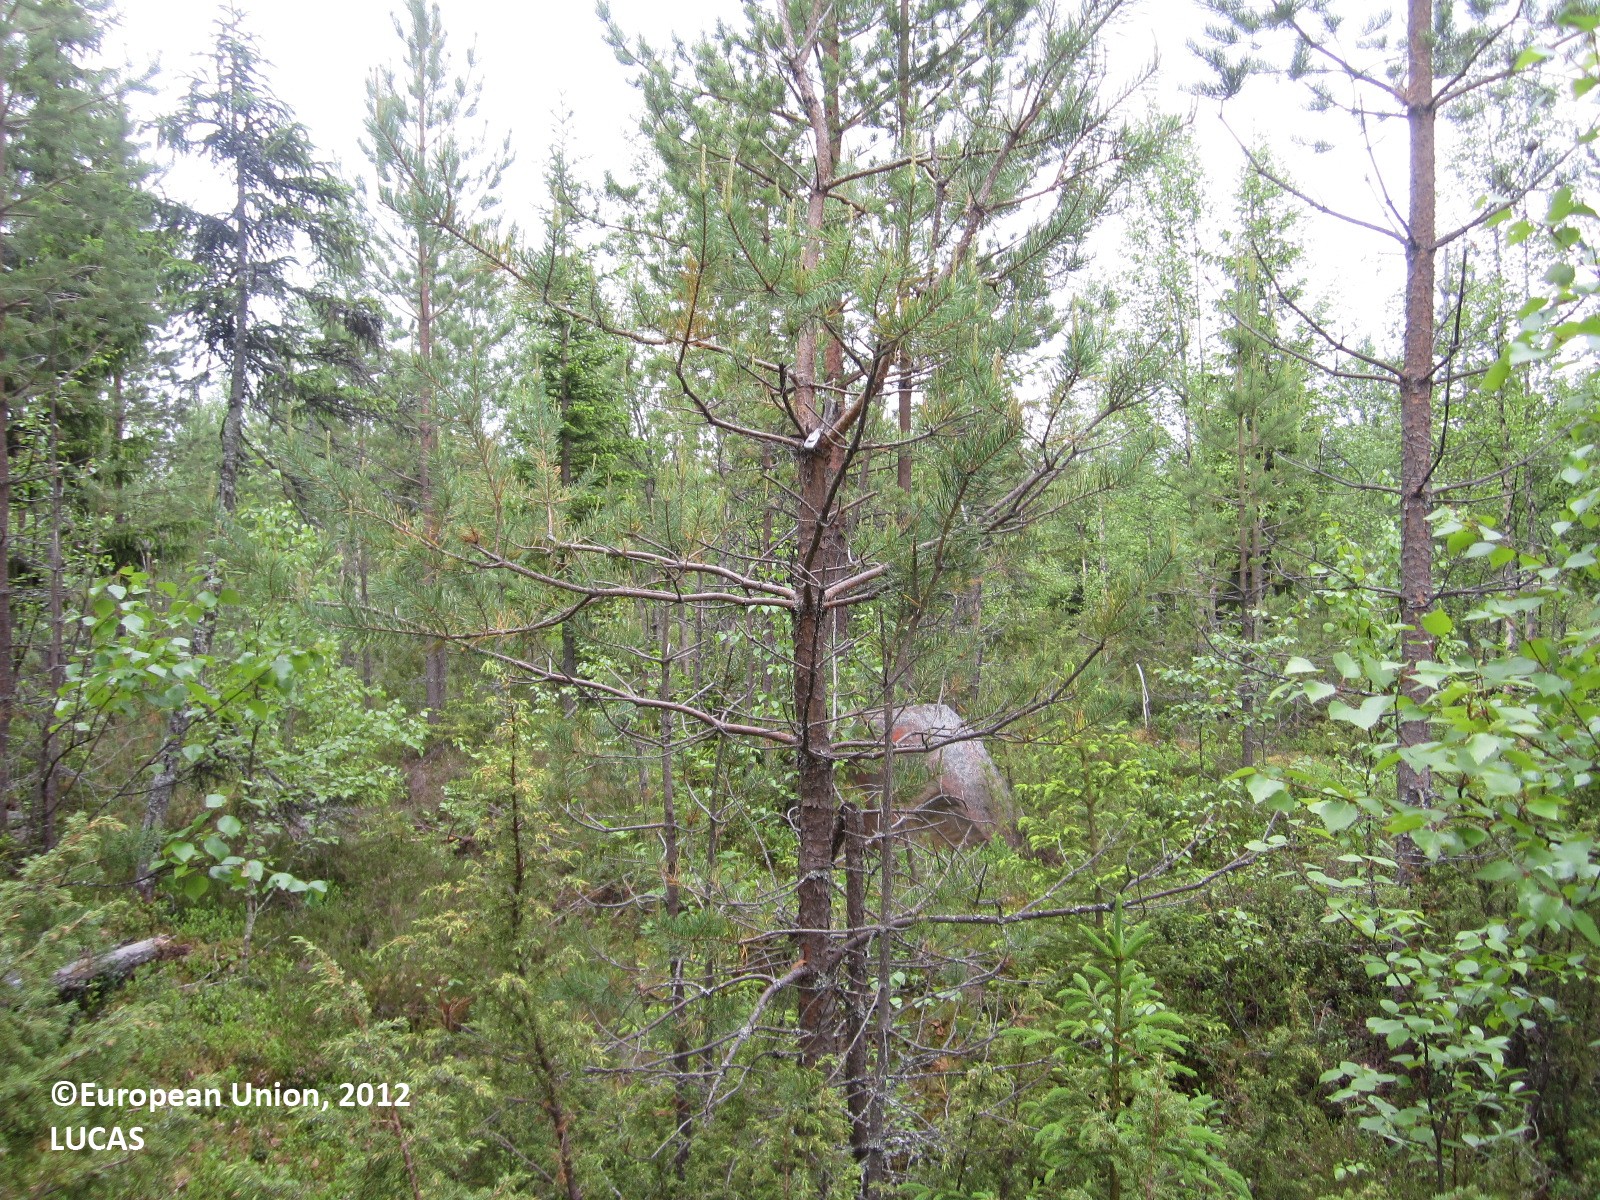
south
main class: Woodland
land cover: Pine dominated mixed woodland
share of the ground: 50 - 75 %
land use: Forestry
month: June
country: FI
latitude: 64.6646
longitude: 29.6755
